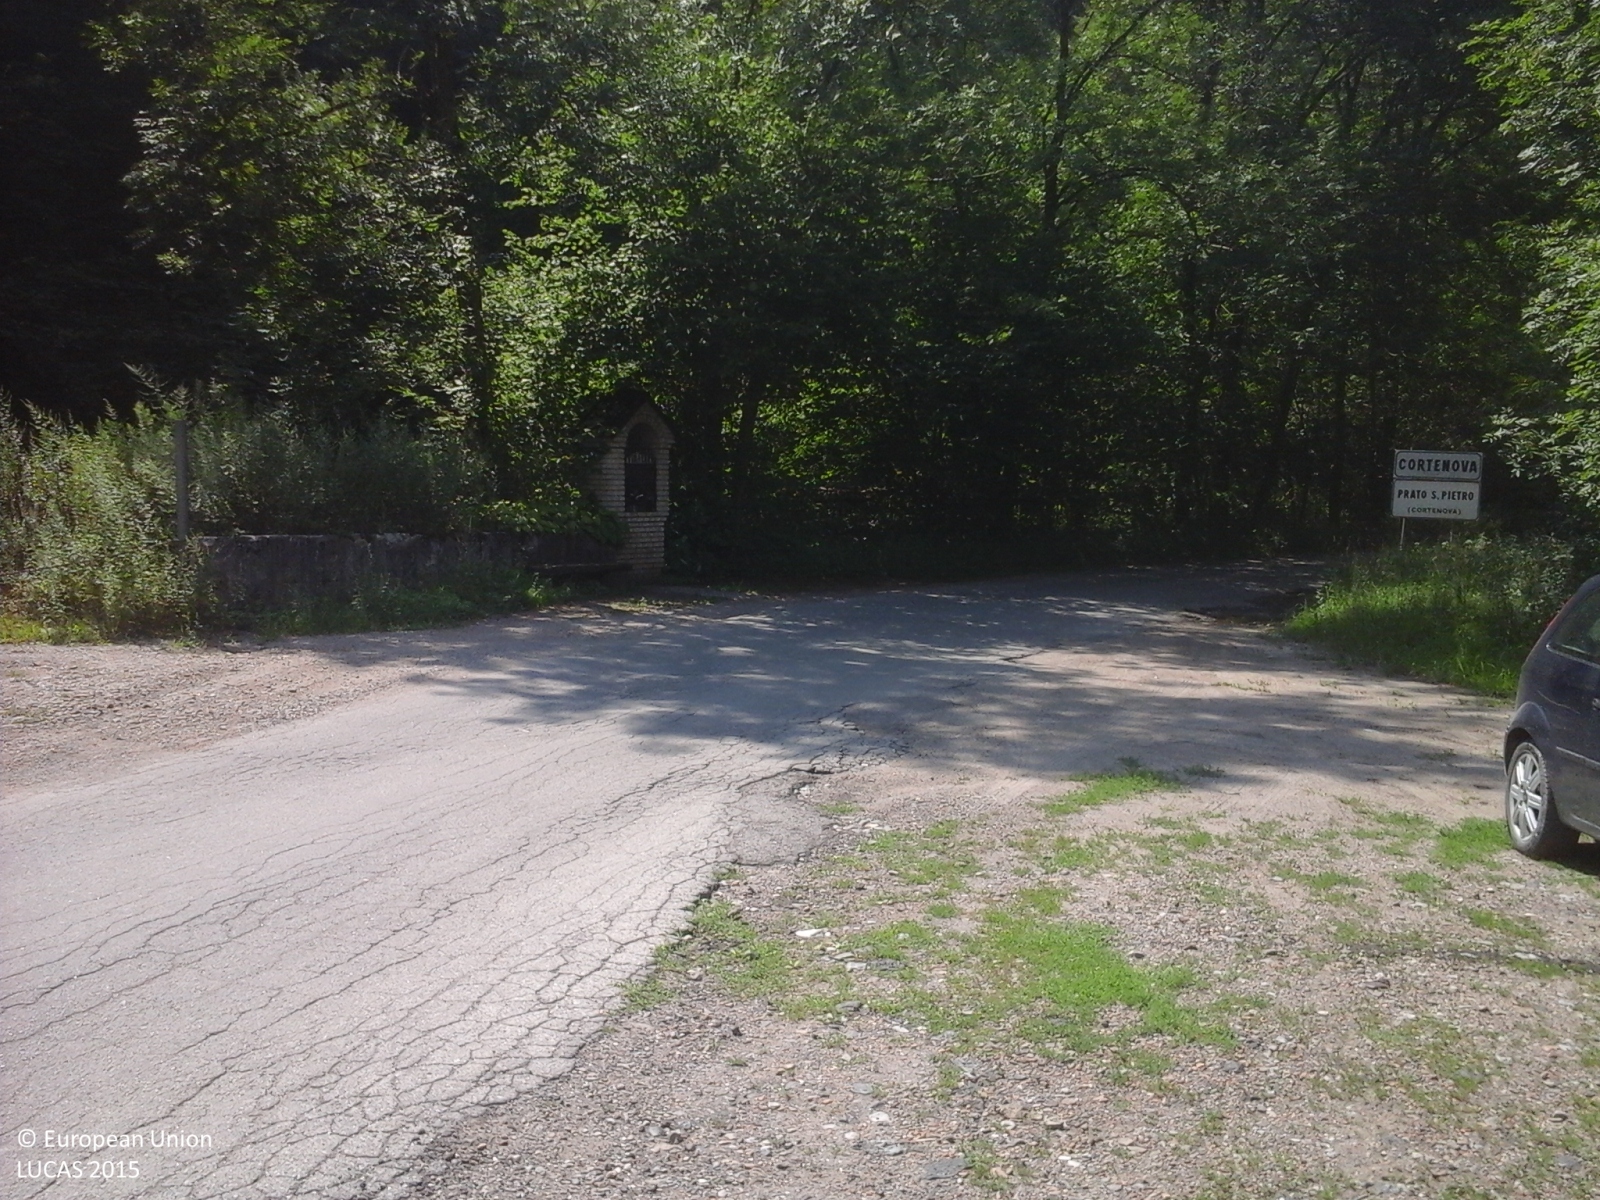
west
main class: Woodland
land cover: Broadleaved woodland
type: thermophilous deciduous forest
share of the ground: > 75 %
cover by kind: broadleaved forest trees 100 %
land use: Forestry
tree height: > 5 m
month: August
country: IT
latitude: 45.9892
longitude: 9.3941
